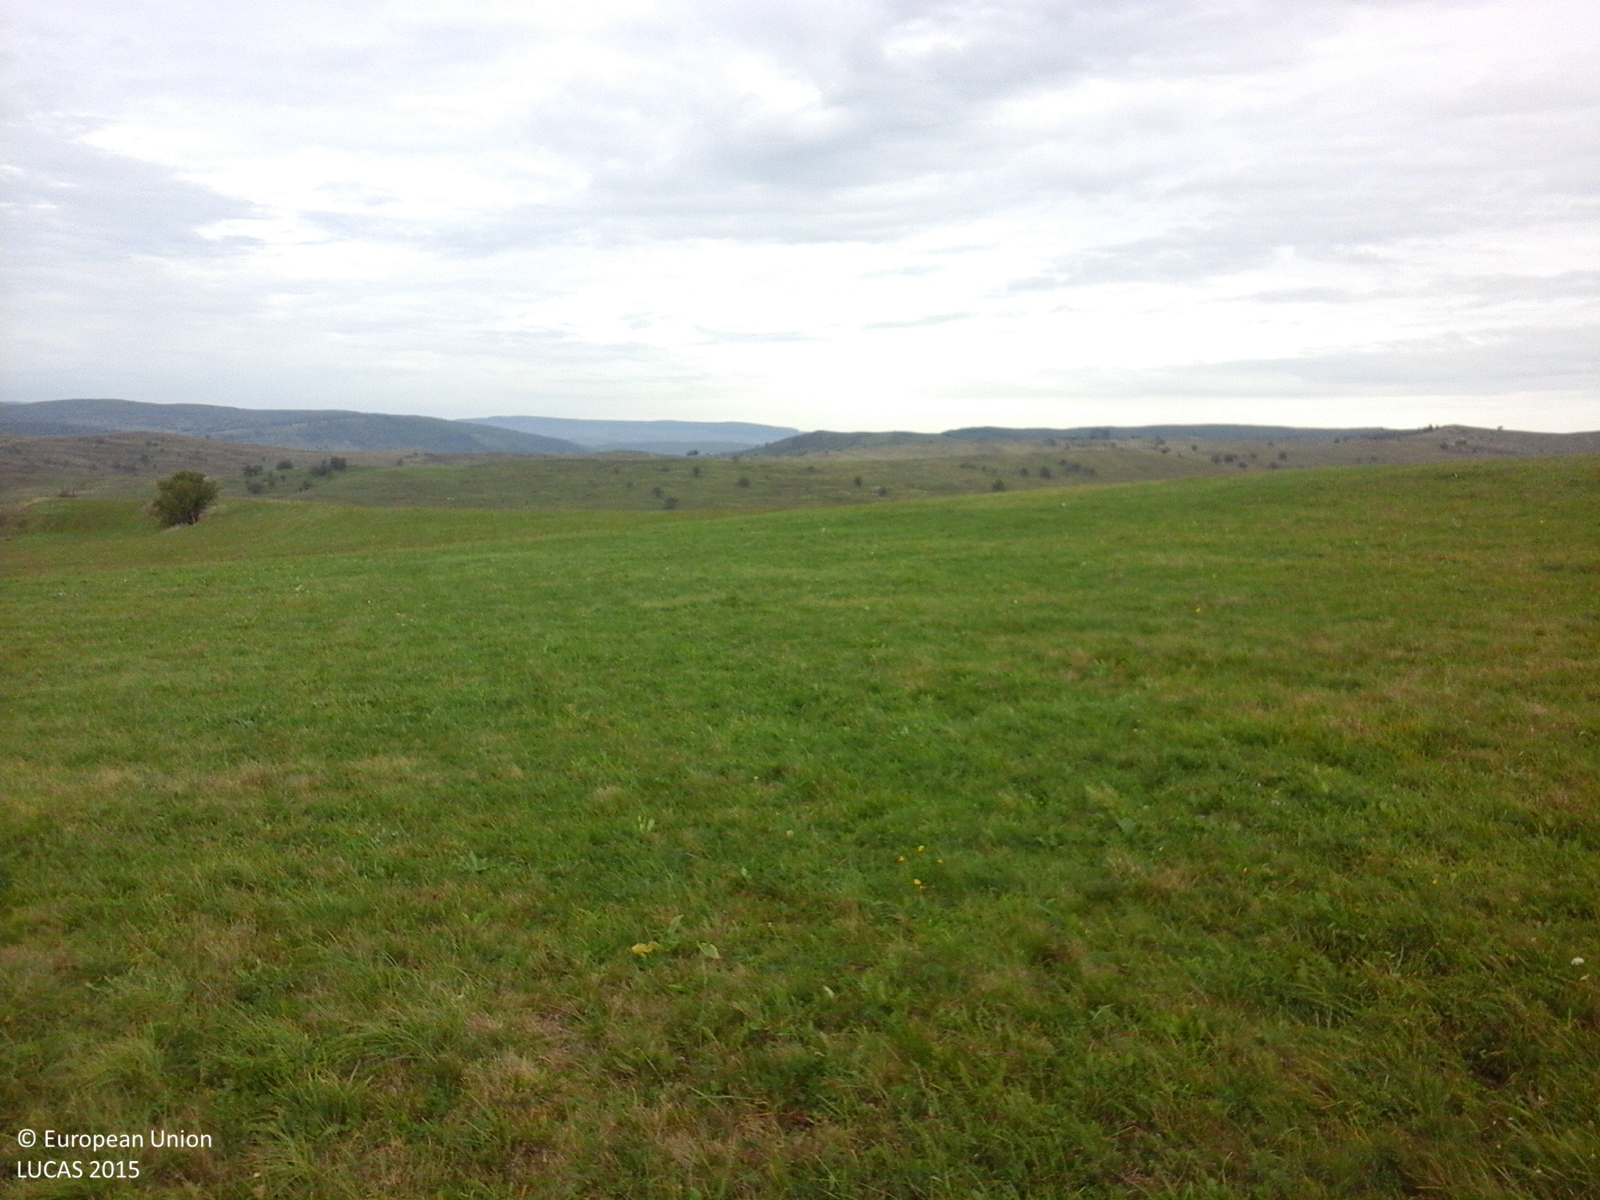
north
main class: Grassland
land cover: Grassland without tree/shrub cover
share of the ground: > 75 %
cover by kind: herbaceous plants 100 %
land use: Agriculture (excluding fallow land and kitchen gardens)
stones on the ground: < 10 %
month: October
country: RO
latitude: 46.2335
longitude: 25.2863
